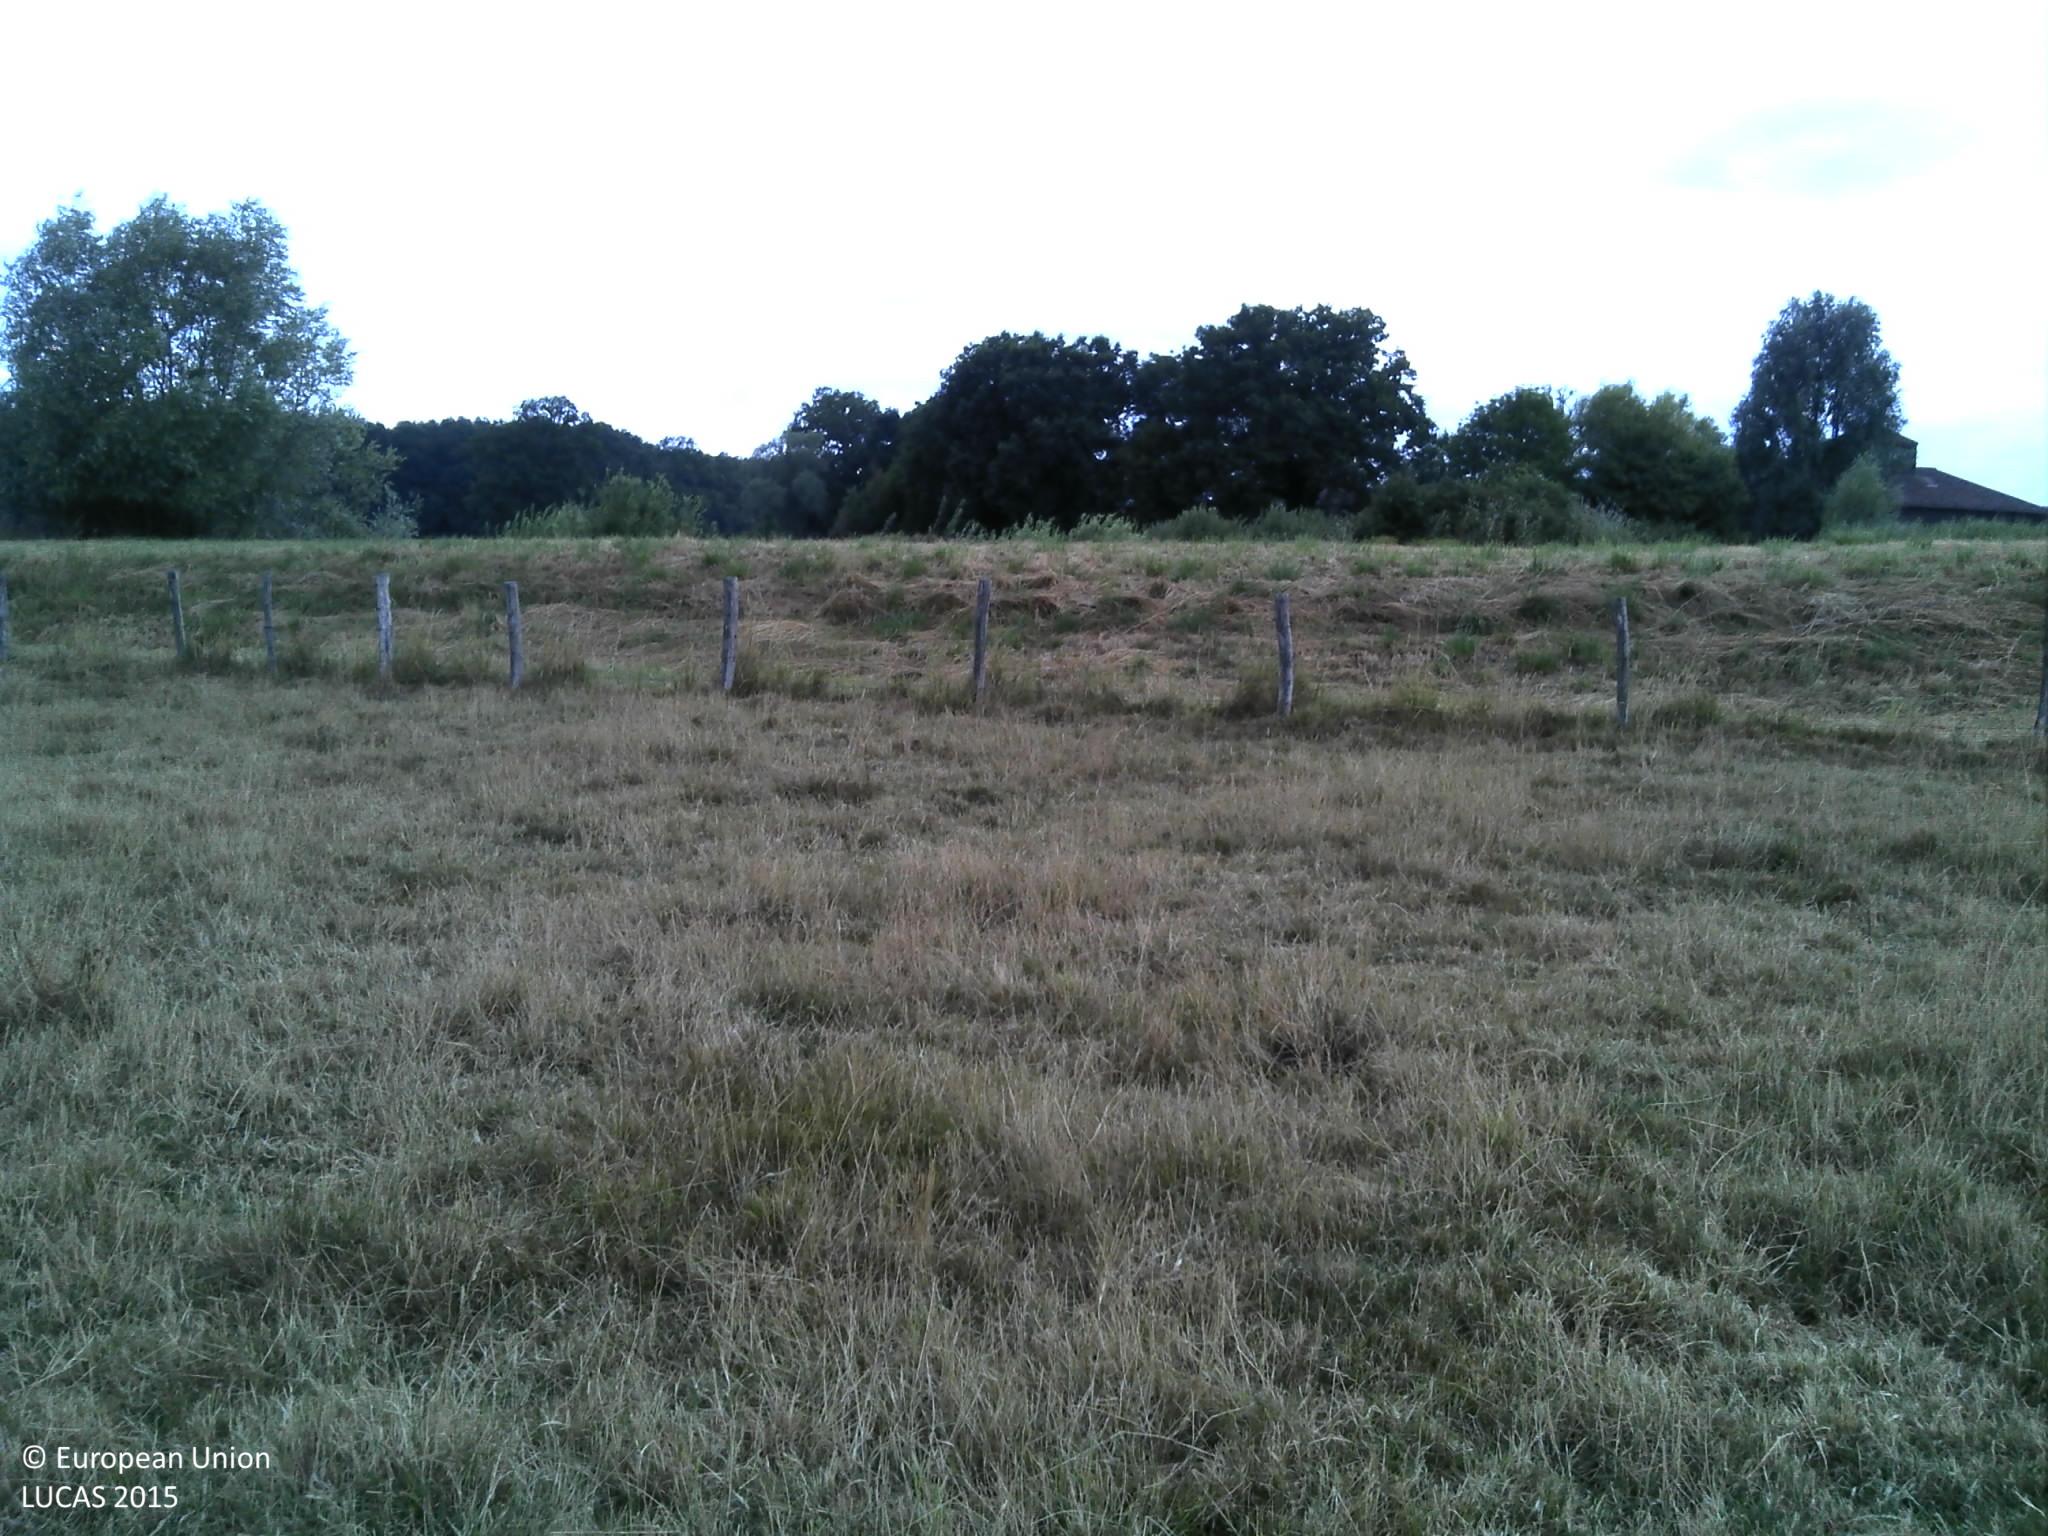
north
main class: Grassland
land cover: Grassland without tree/shrub cover
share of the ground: > 75 %
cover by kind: herbaceous plants 100 %
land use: Agriculture (excluding fallow land and kitchen gardens)
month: July
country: FR
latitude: 48.5649
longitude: 4.6992
